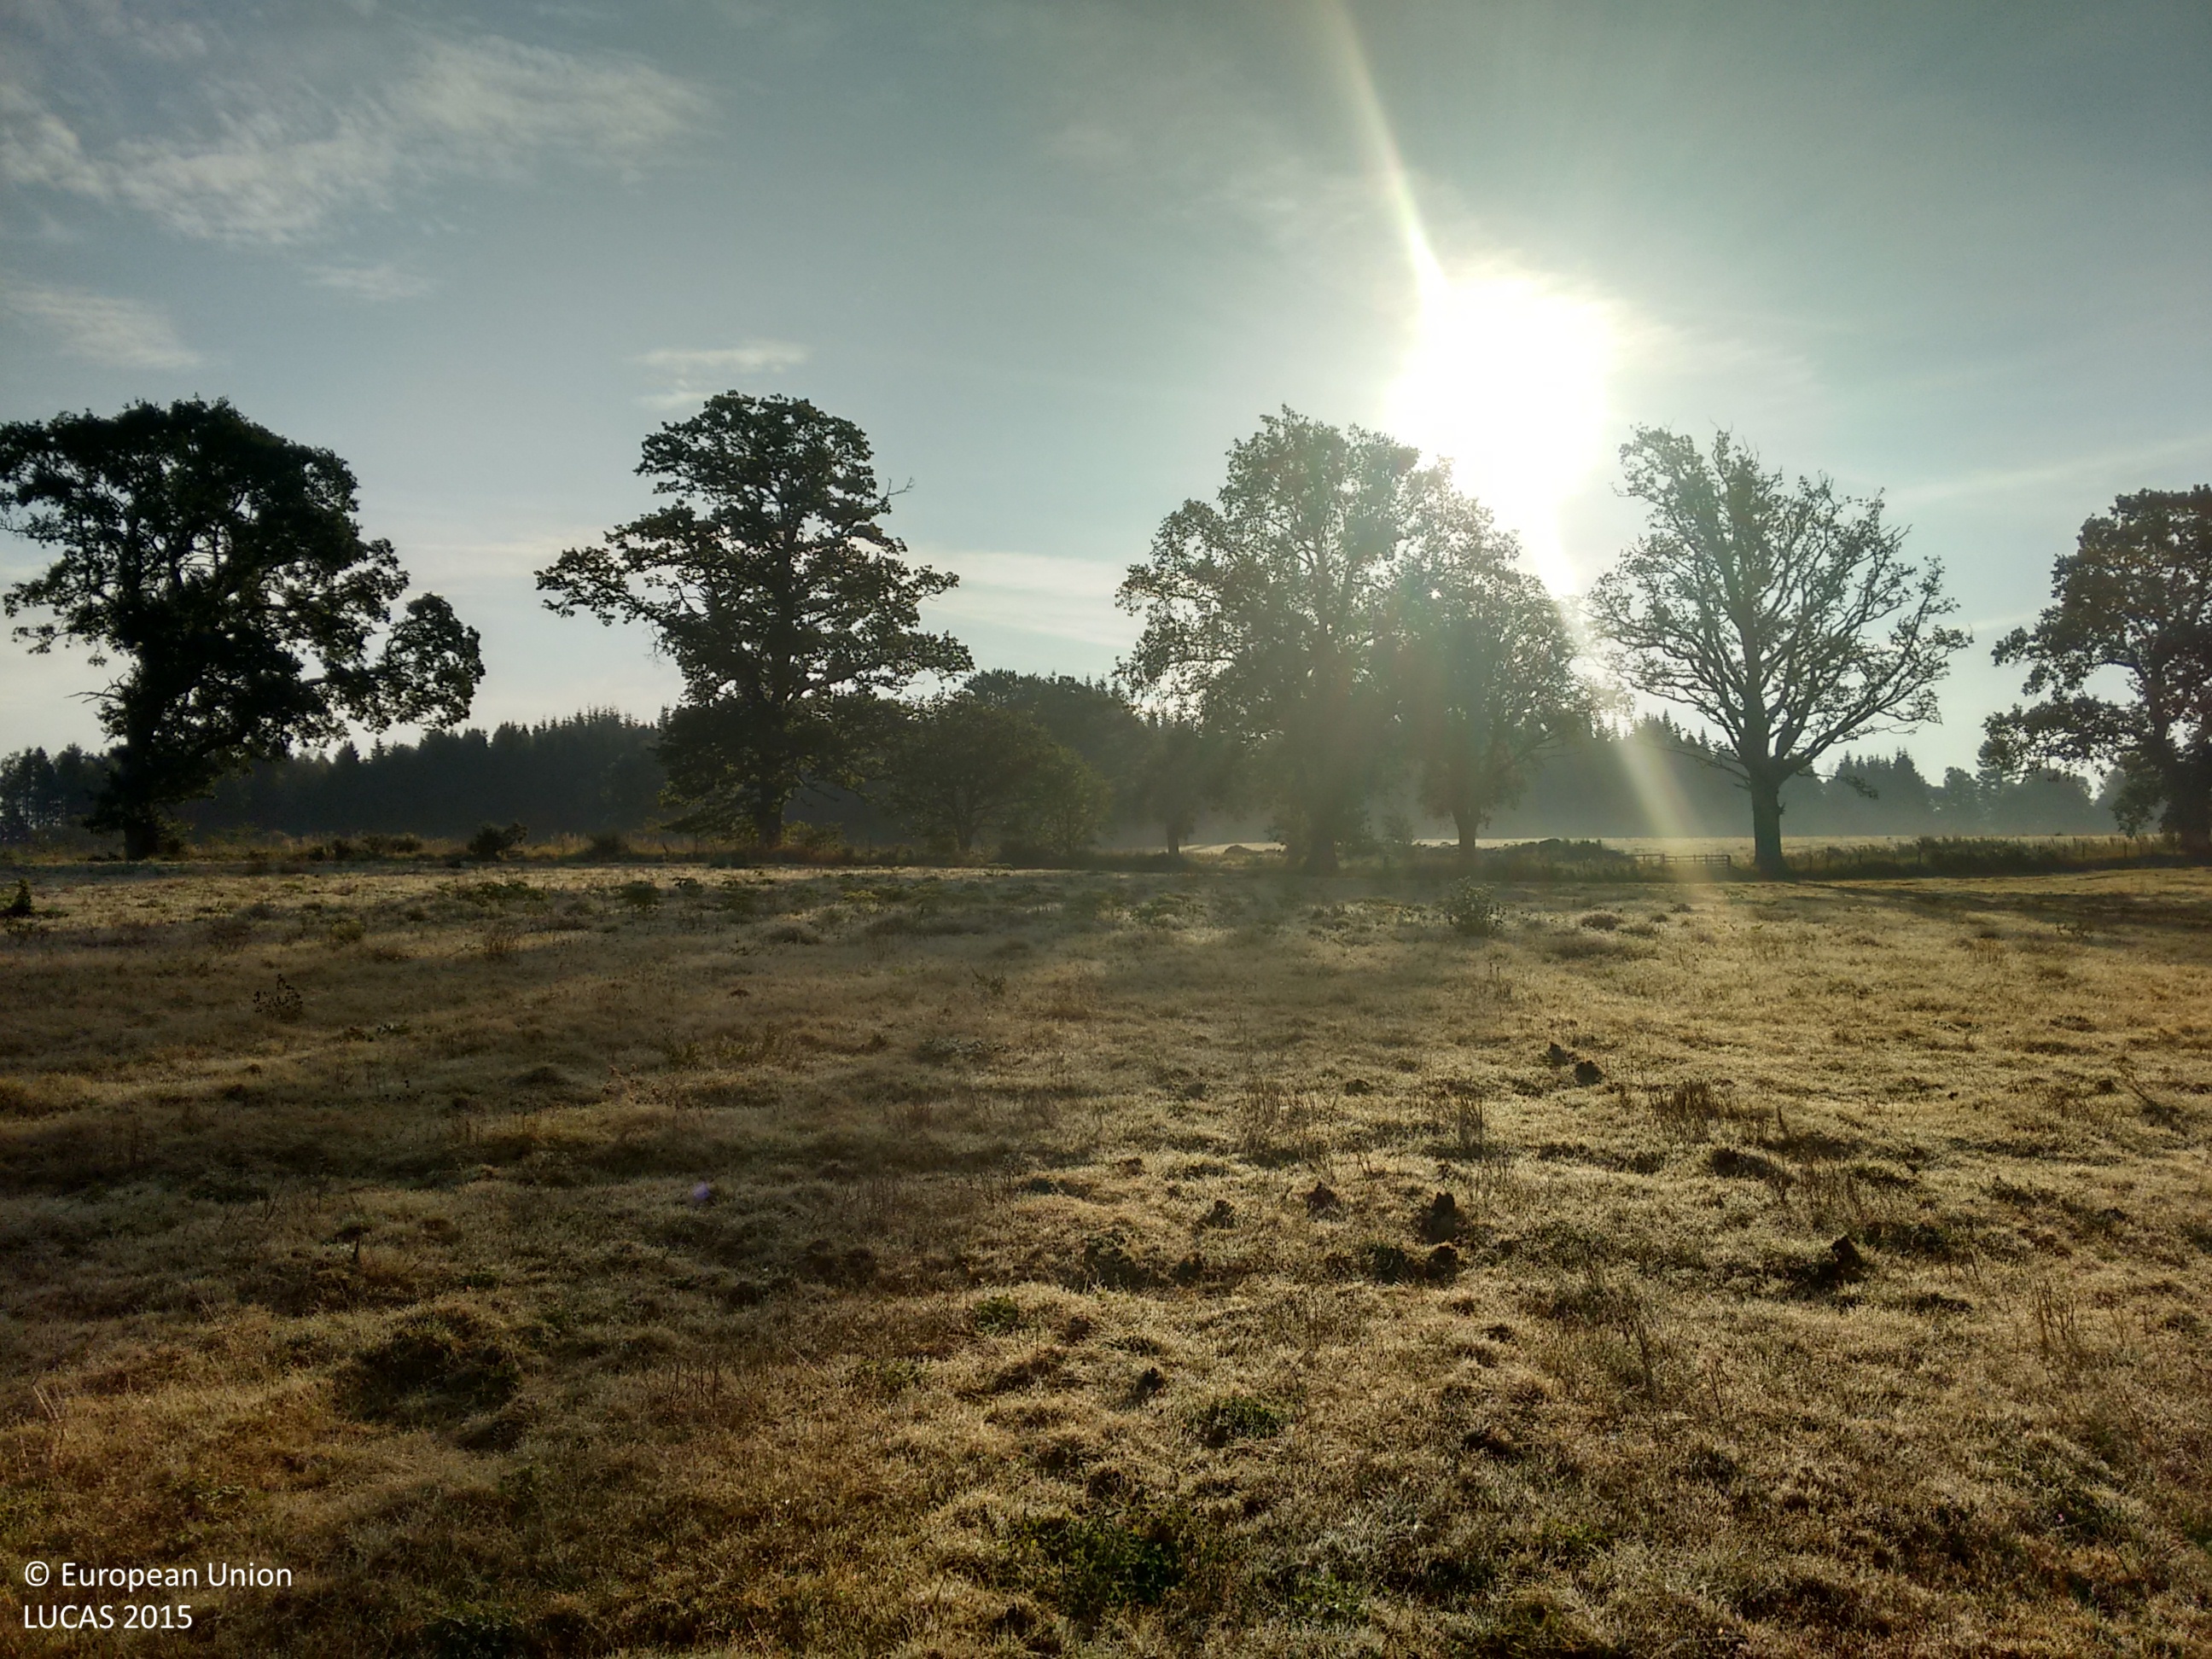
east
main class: Grassland
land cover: Grassland without tree/shrub cover
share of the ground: > 75 %
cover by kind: herbaceous plants 100 %
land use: Agriculture (excluding fallow land and kitchen gardens)
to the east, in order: Grassland without tree/shrub cover; Fences; Lines of trees; Ditches and canals; Grass margins; Barley; Grass margins; Fences; Shrubland with sparse tree cover
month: September
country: GB
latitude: 56.3312
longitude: -3.8133
